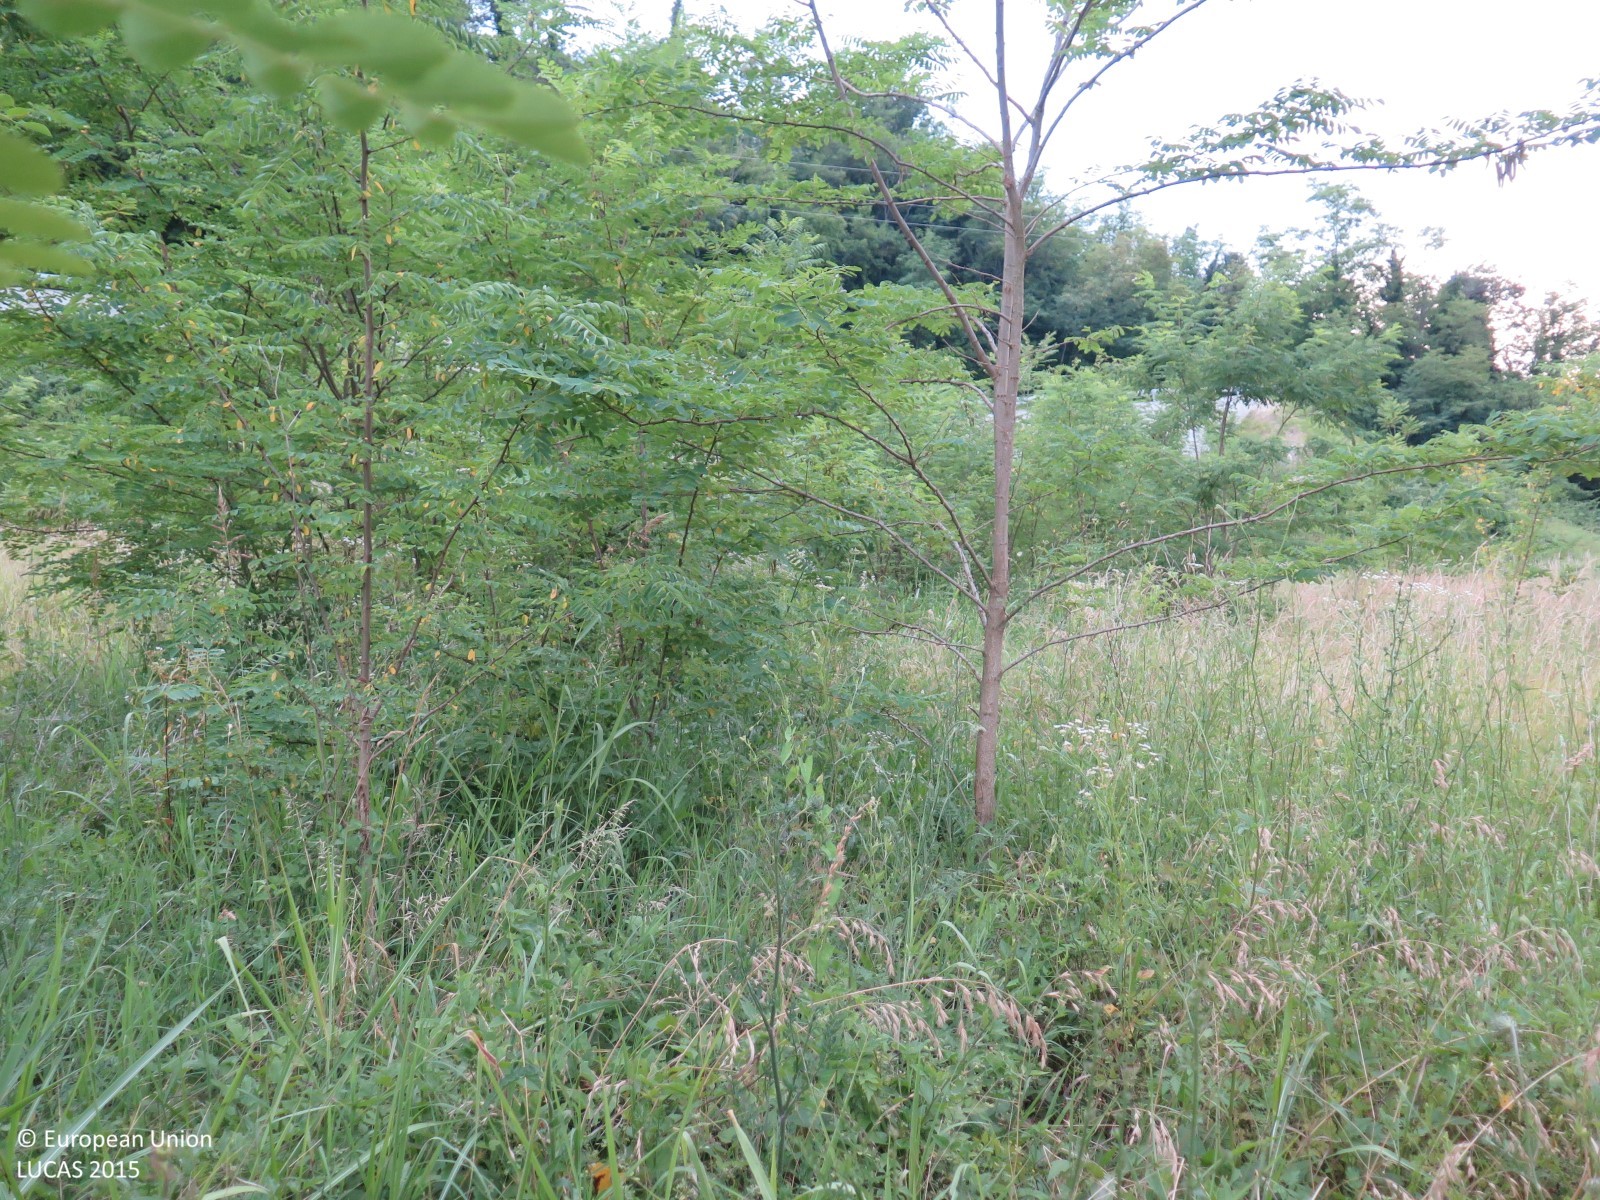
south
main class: Grassland
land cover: Grassland with sparse tree/shrub cover
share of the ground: > 75 %
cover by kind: herbaceous plants 90 %, broadleaved forest trees 5 %, shrubs 5 %
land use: Semi-natural and natural areas not in use
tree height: > 5 m
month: July
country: HR
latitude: 45.3274
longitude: 13.8099
